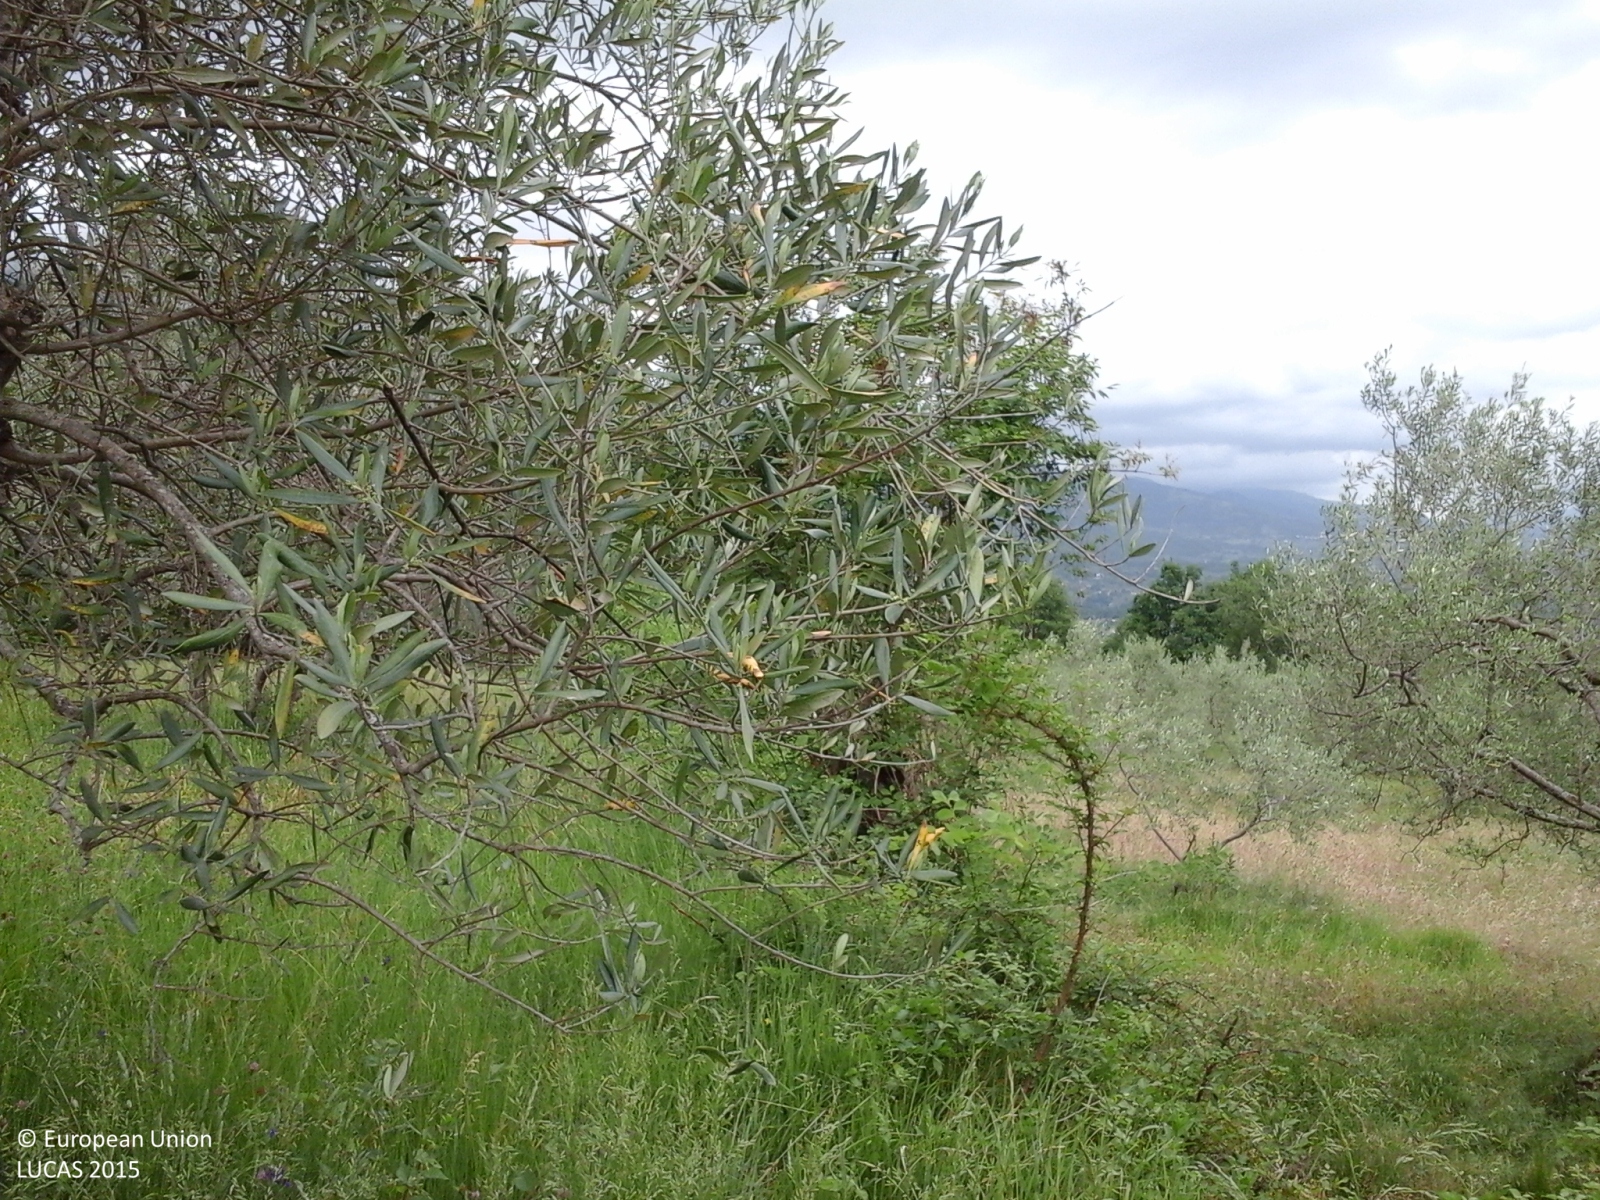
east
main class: Cropland
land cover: Olive groves
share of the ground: 50 - 75 %
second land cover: Grassland without tree/shrub cover
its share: > 75 %
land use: Agriculture (excluding fallow land and kitchen gardens)
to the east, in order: Olive groves; Grassland without tree/shrub cover; Abandoned hedges; Dry stone walls; Grassland without tree/shrub cover; Broadleaved woodland; Abandoned hedges; Dry stone walls; Olive groves
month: May
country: IT
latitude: 41.7157
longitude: 13.7725
